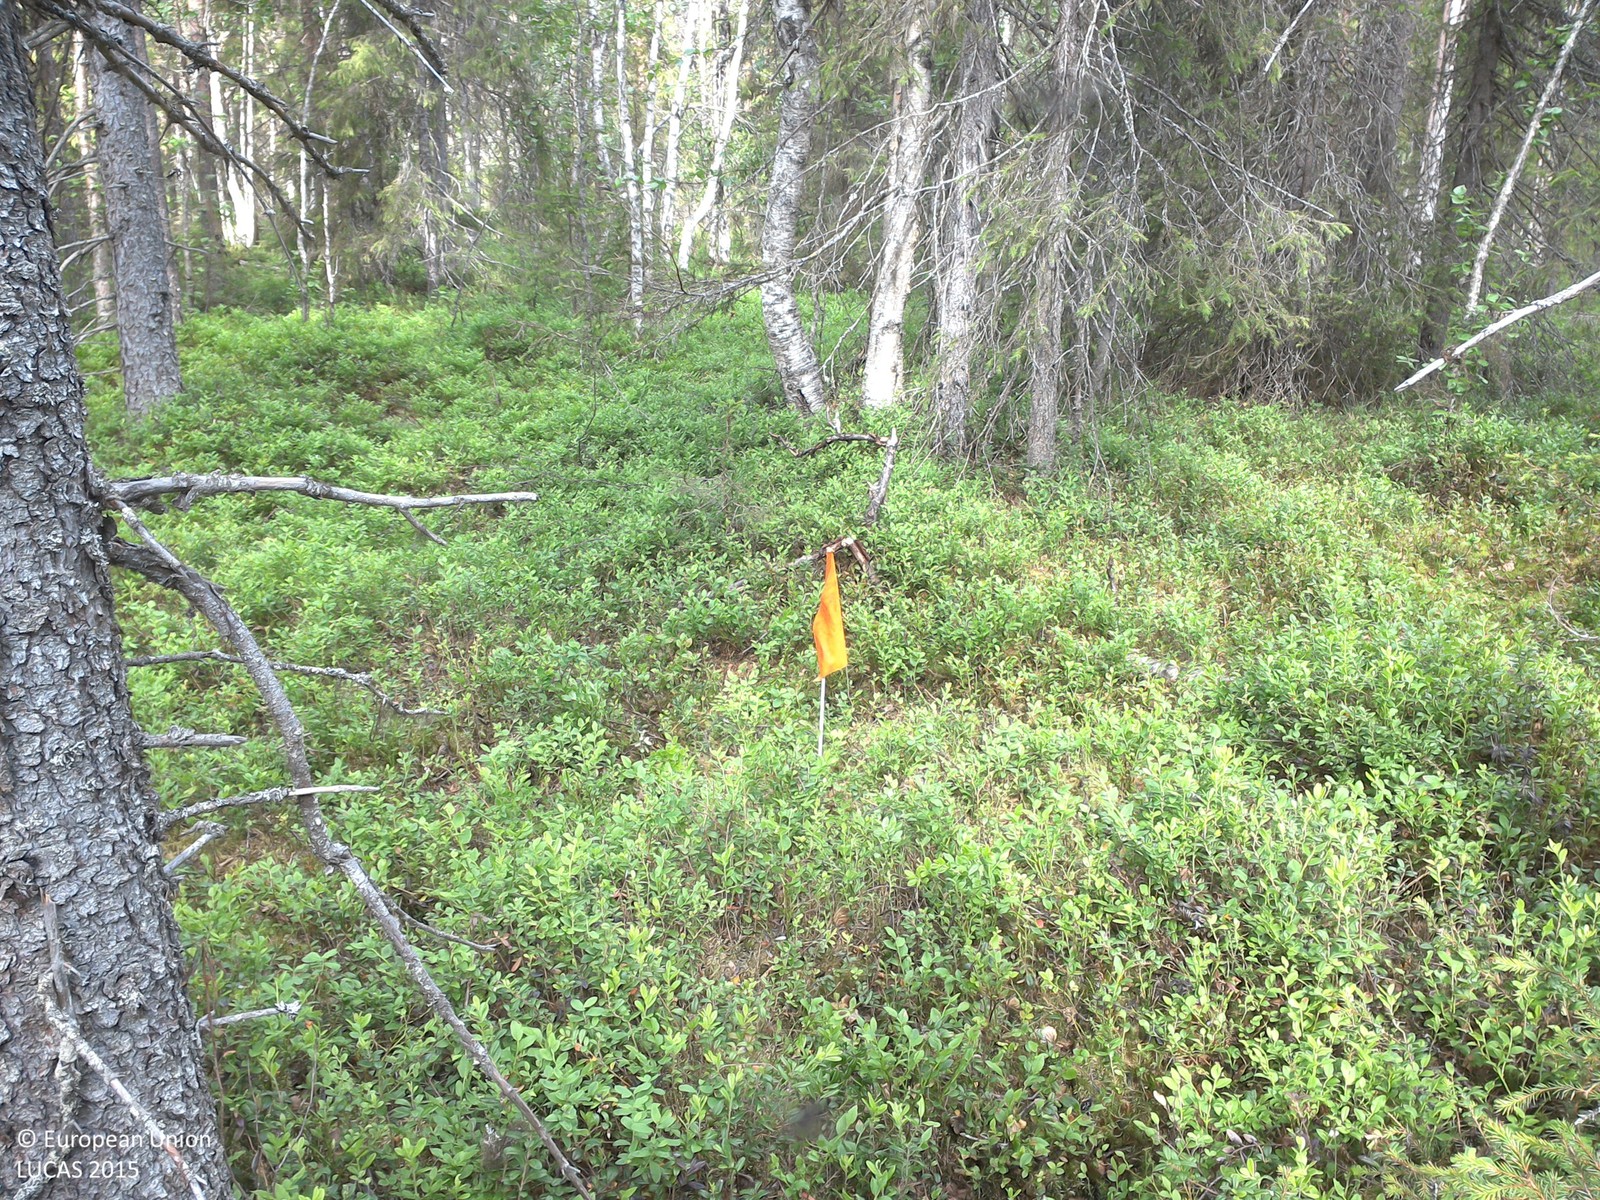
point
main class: Woodland
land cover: Spruce dominated mixed woodland
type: boreal forest
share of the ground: 25 - 50 %
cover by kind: shrubs 55 %, coniferous forest trees 30 %, broadleaved forest trees 10 %, lichens and mosses 5 %
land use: Forestry
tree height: > 5 m
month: July
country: SE
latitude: 67.1392
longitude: 22.6744
